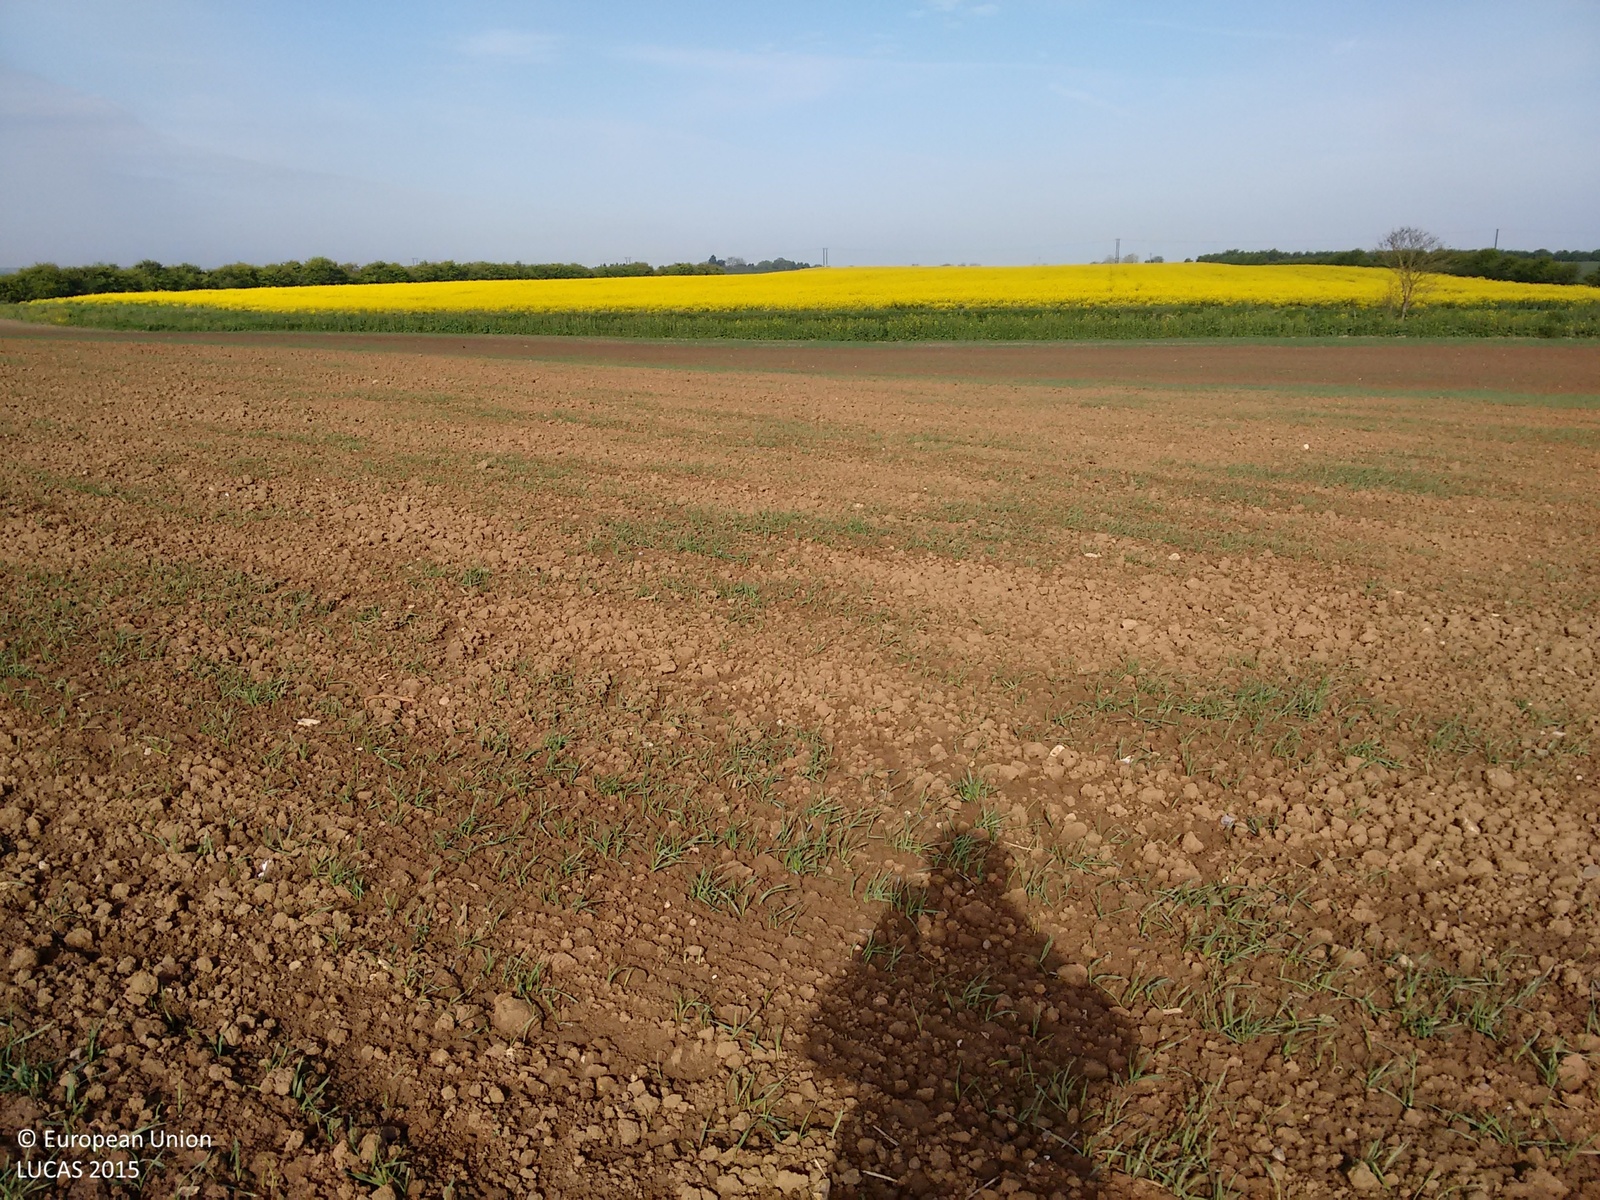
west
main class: Cropland
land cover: Barley
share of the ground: < 10 %
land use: Agriculture (excluding fallow land and kitchen gardens)
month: May
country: GB
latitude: 53.2759
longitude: 0.2075
